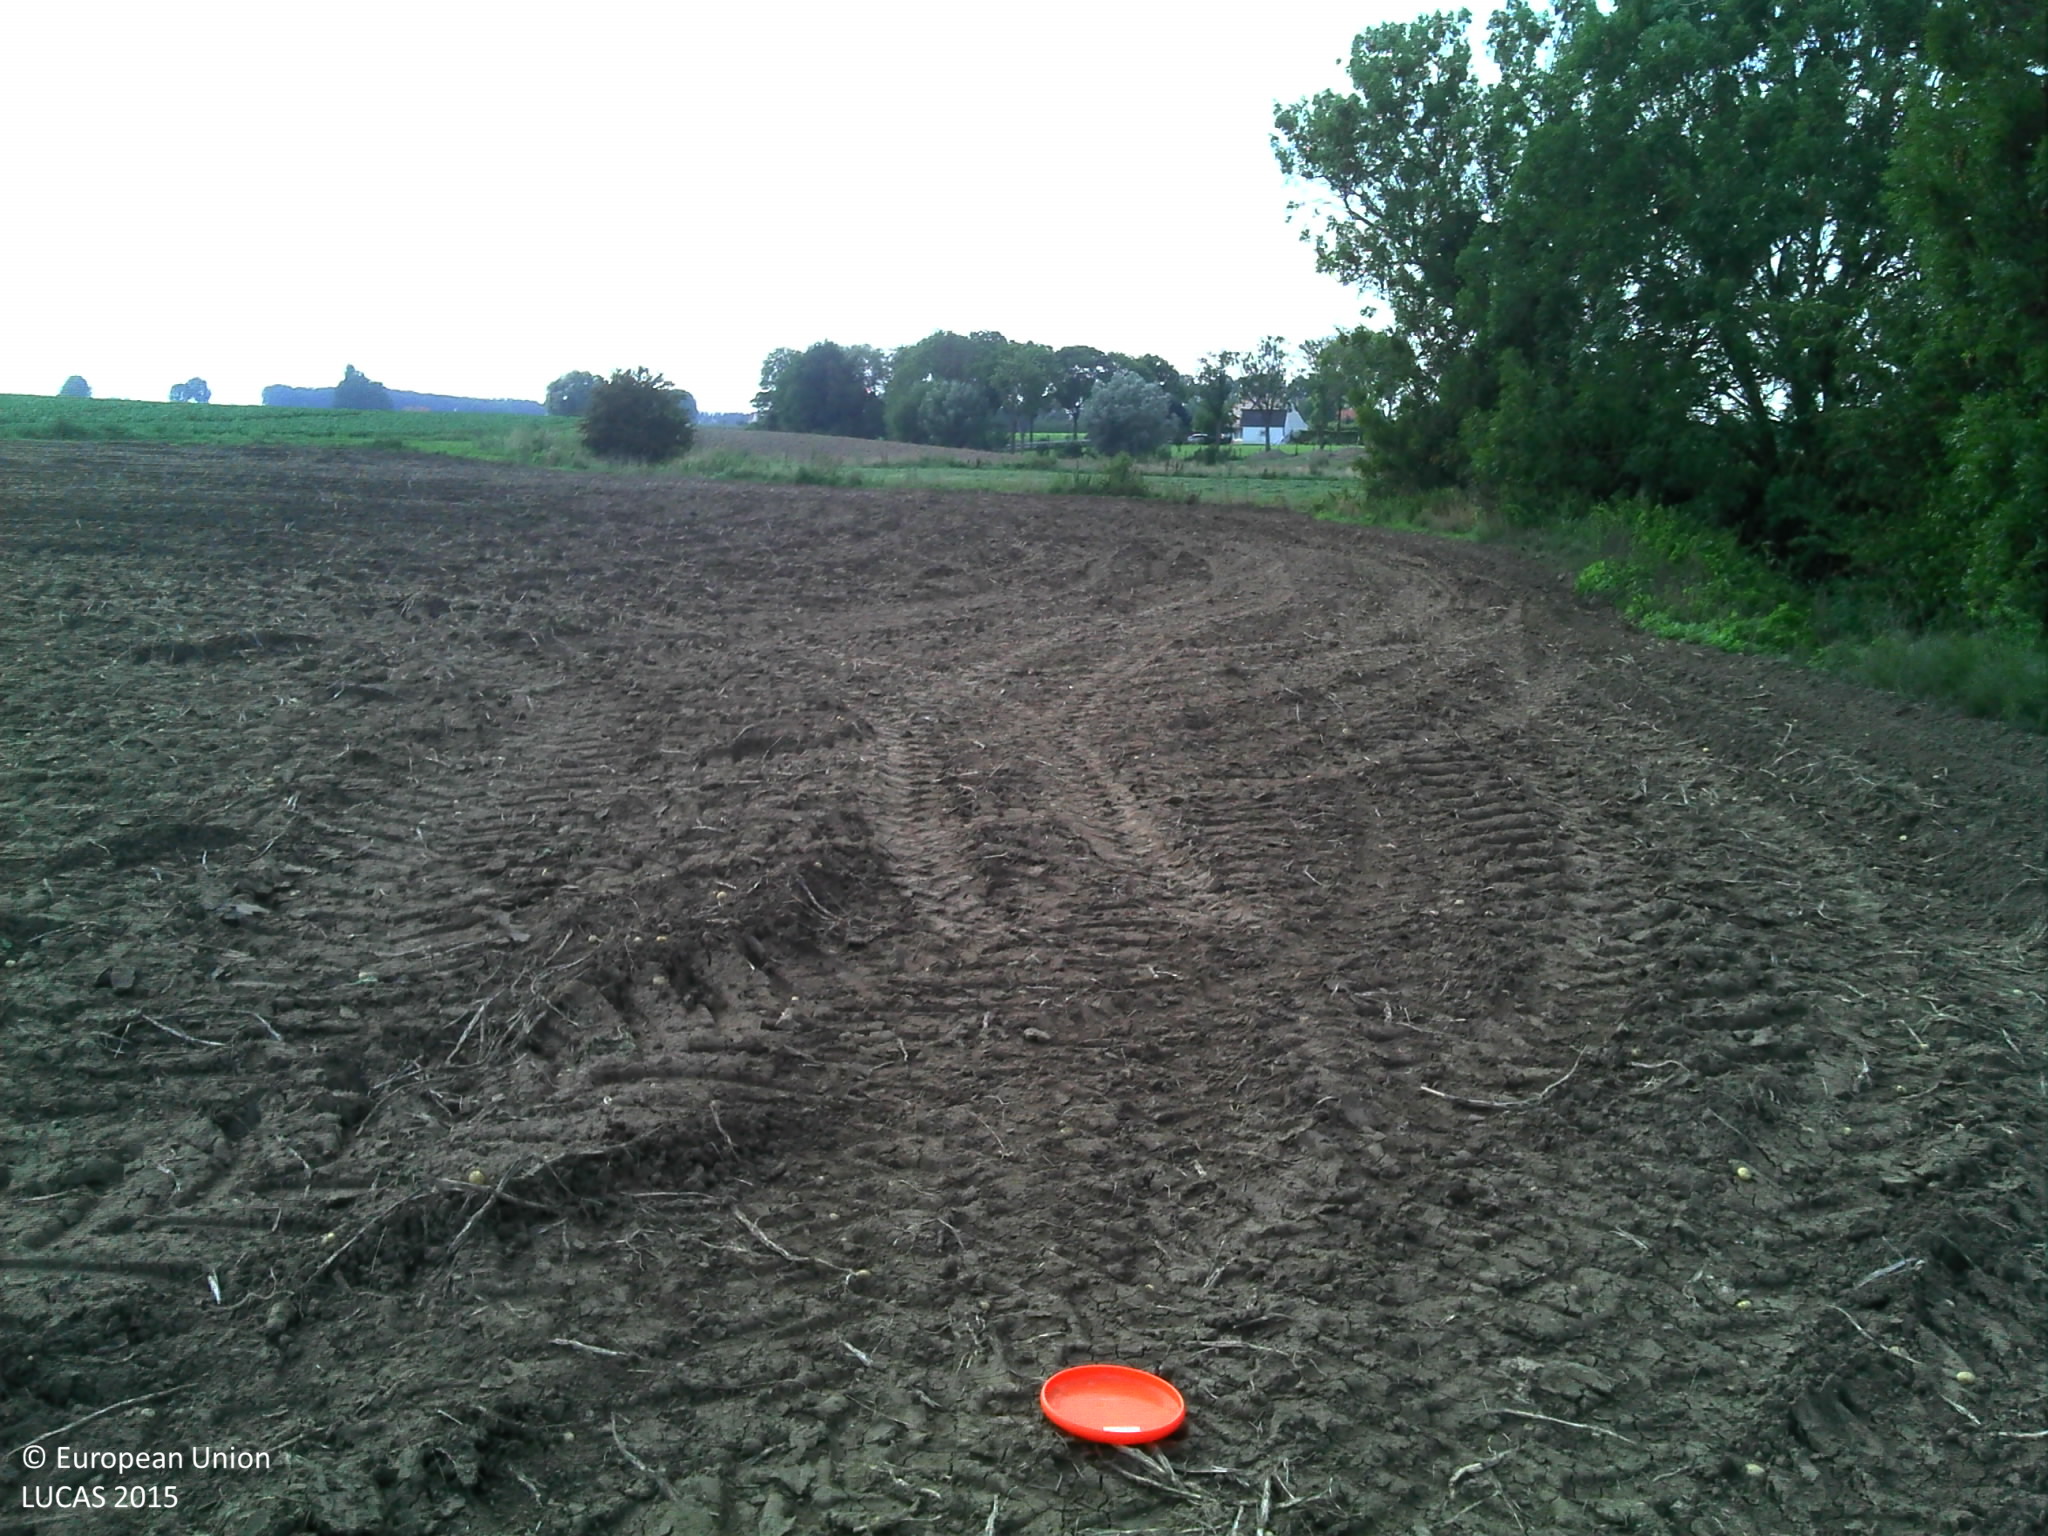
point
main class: Cropland
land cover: Potatoes
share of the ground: < 10 %
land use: Agriculture (excluding fallow land and kitchen gardens)
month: September
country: BE
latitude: 50.8923
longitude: 2.7523
